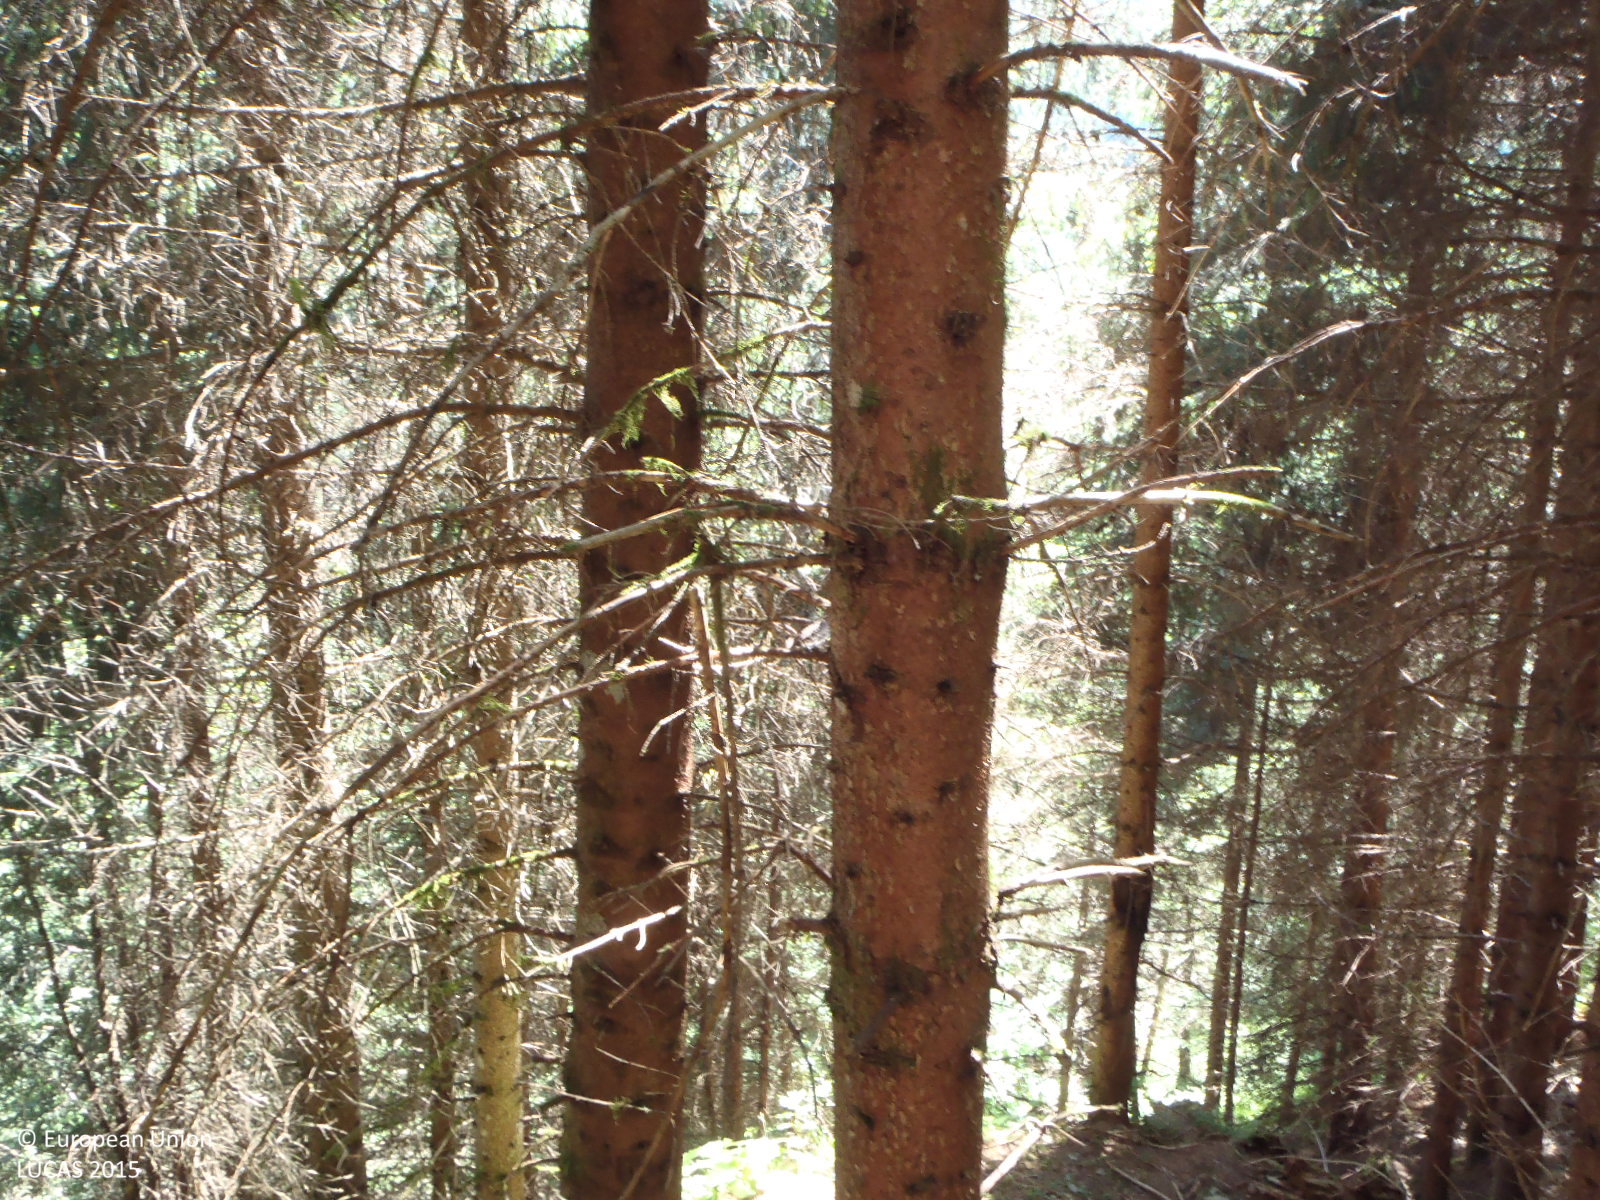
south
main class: Woodland
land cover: Spruce dominated coniferous woodland
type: alpine coniferous forest
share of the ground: > 75 %
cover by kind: coniferous forest trees 95 %, lichens and mosses 5 %
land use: Forestry
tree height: > 5 m
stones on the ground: < 10 %
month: July
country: AT
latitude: 47.3873
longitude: 12.3959
